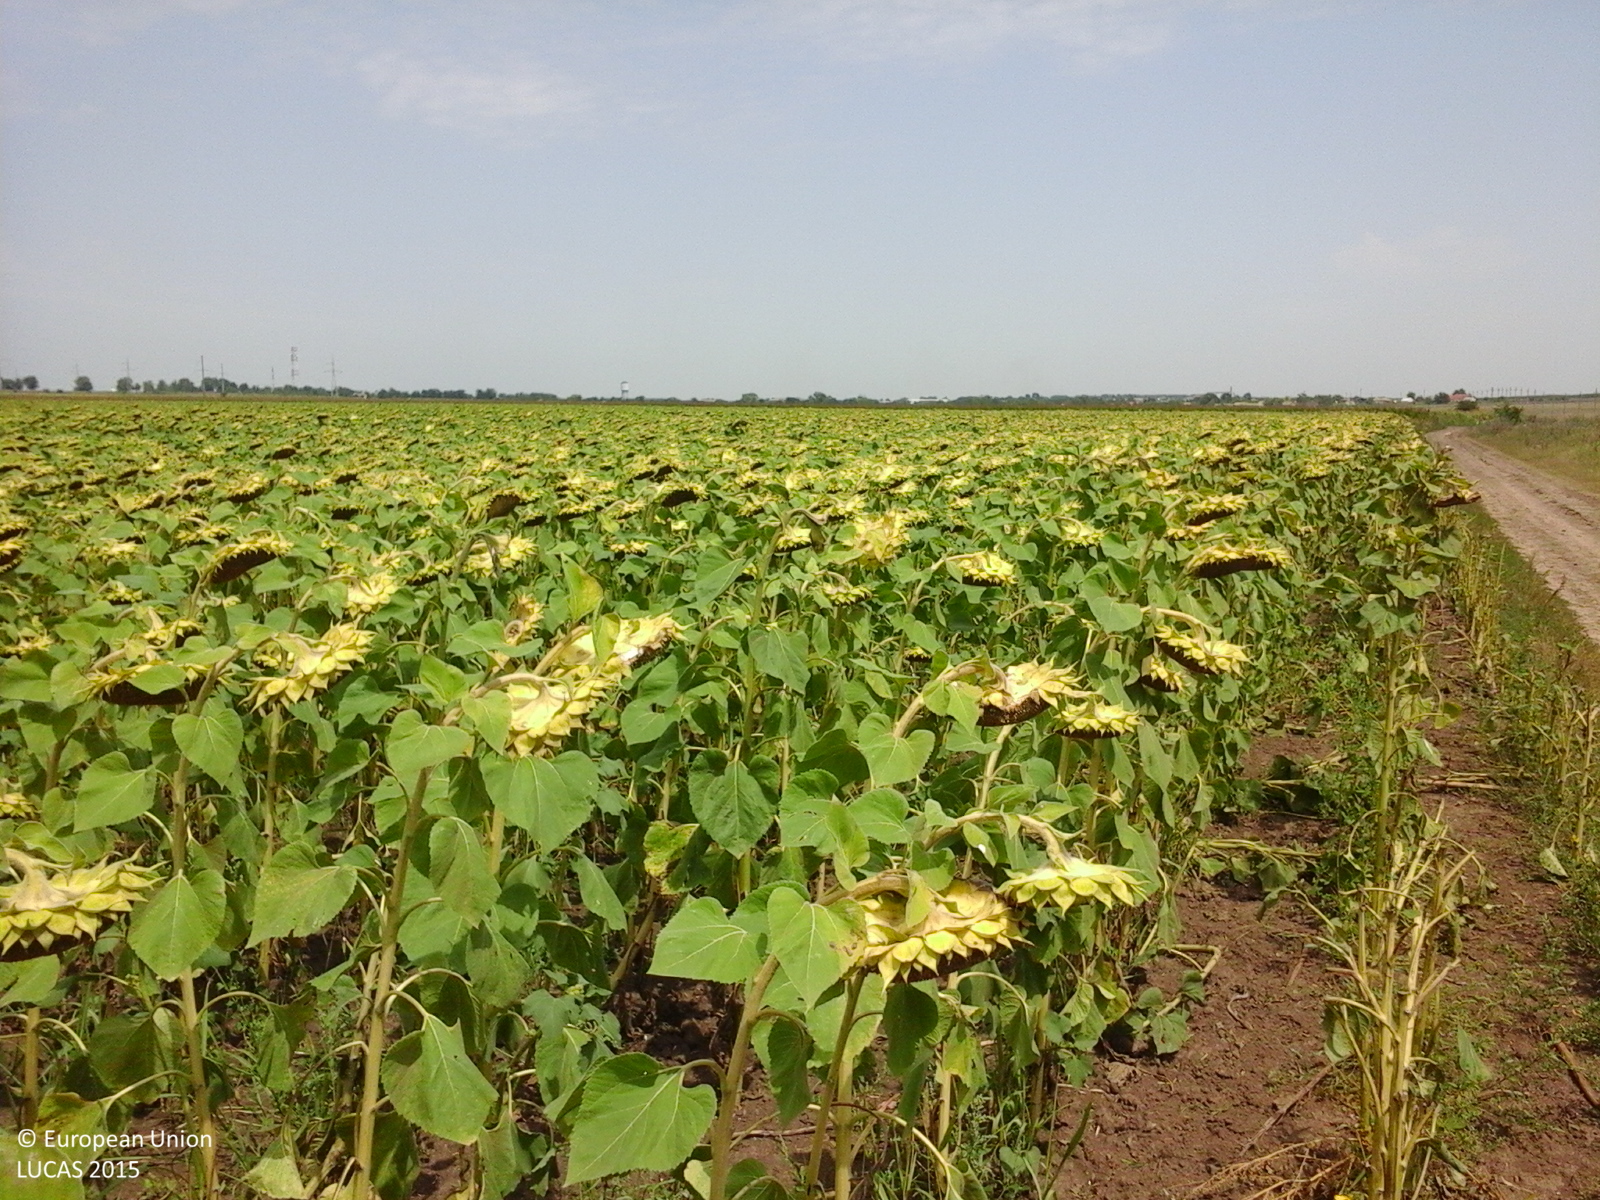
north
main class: Cropland
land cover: Sunflower
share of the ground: > 75 %
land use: Agriculture (excluding fallow land and kitchen gardens)
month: August
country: RO
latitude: 43.9447
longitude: 28.3913
